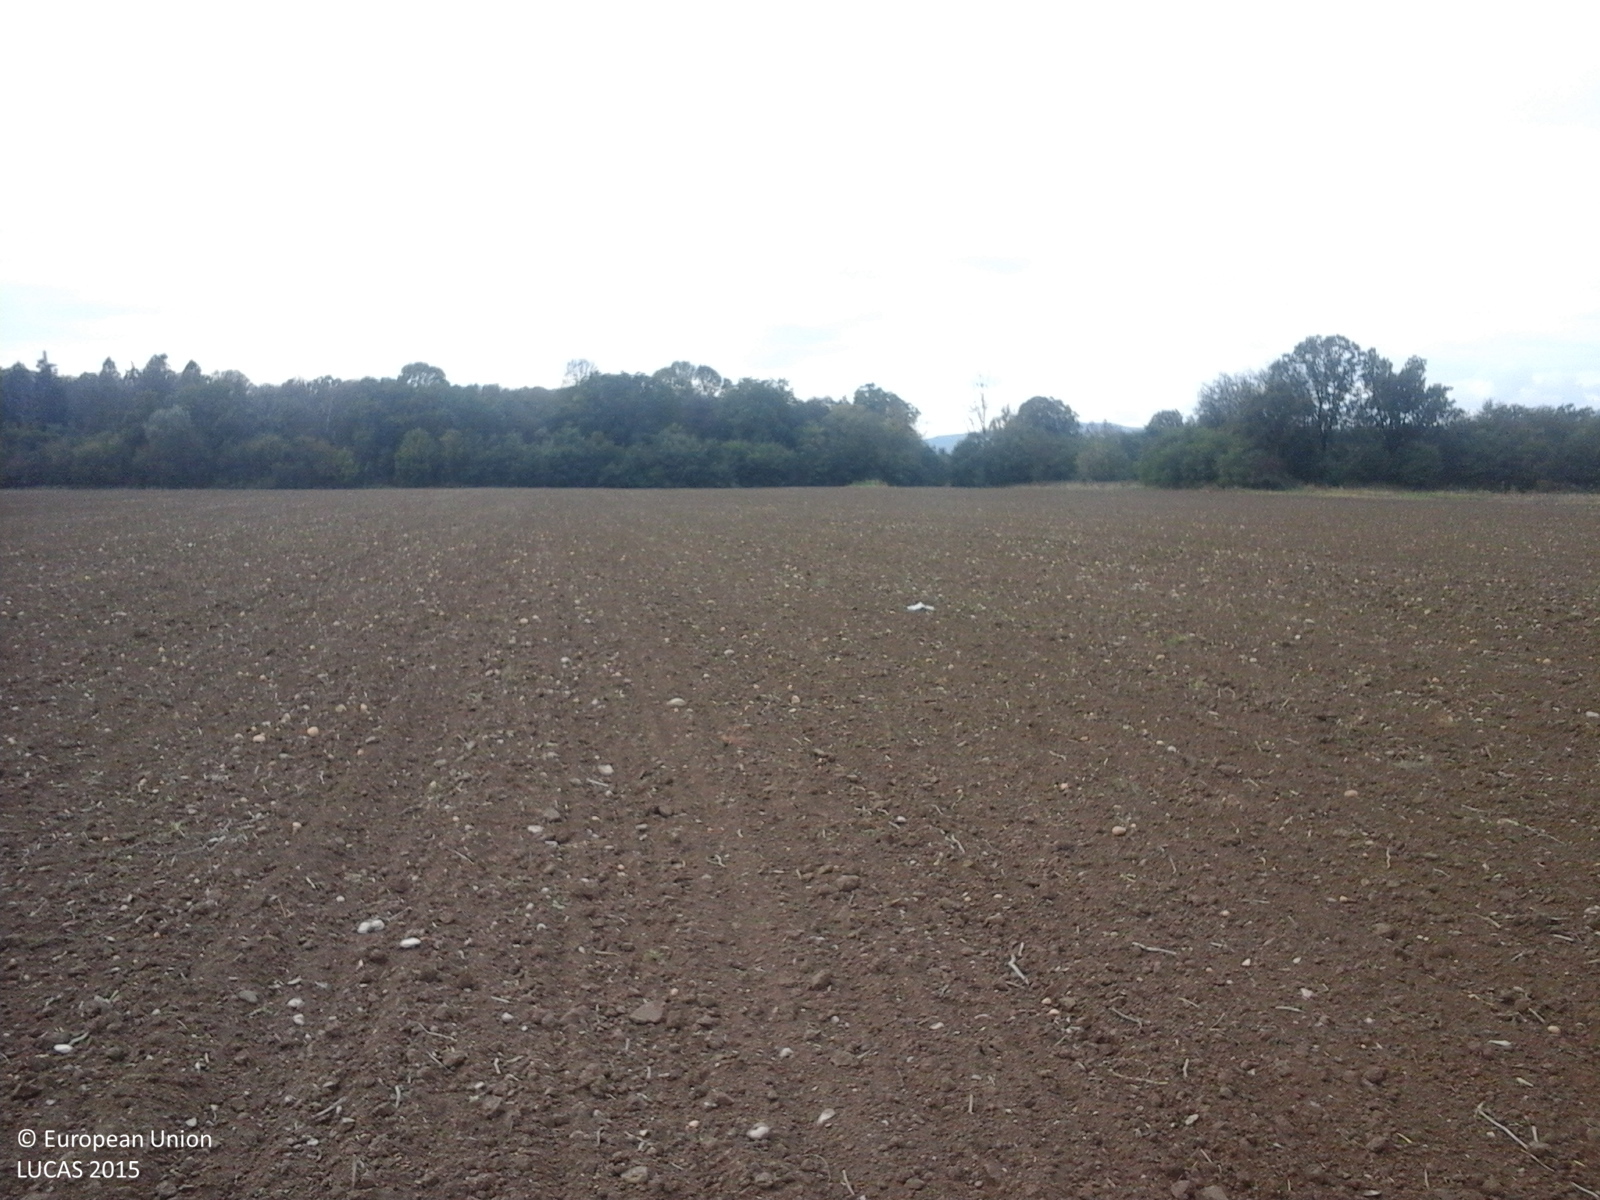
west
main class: Cropland
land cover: Potatoes
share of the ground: 50 - 75 %
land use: Agriculture (excluding fallow land and kitchen gardens)
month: October
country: RO
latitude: 45.7916
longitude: 24.7915
